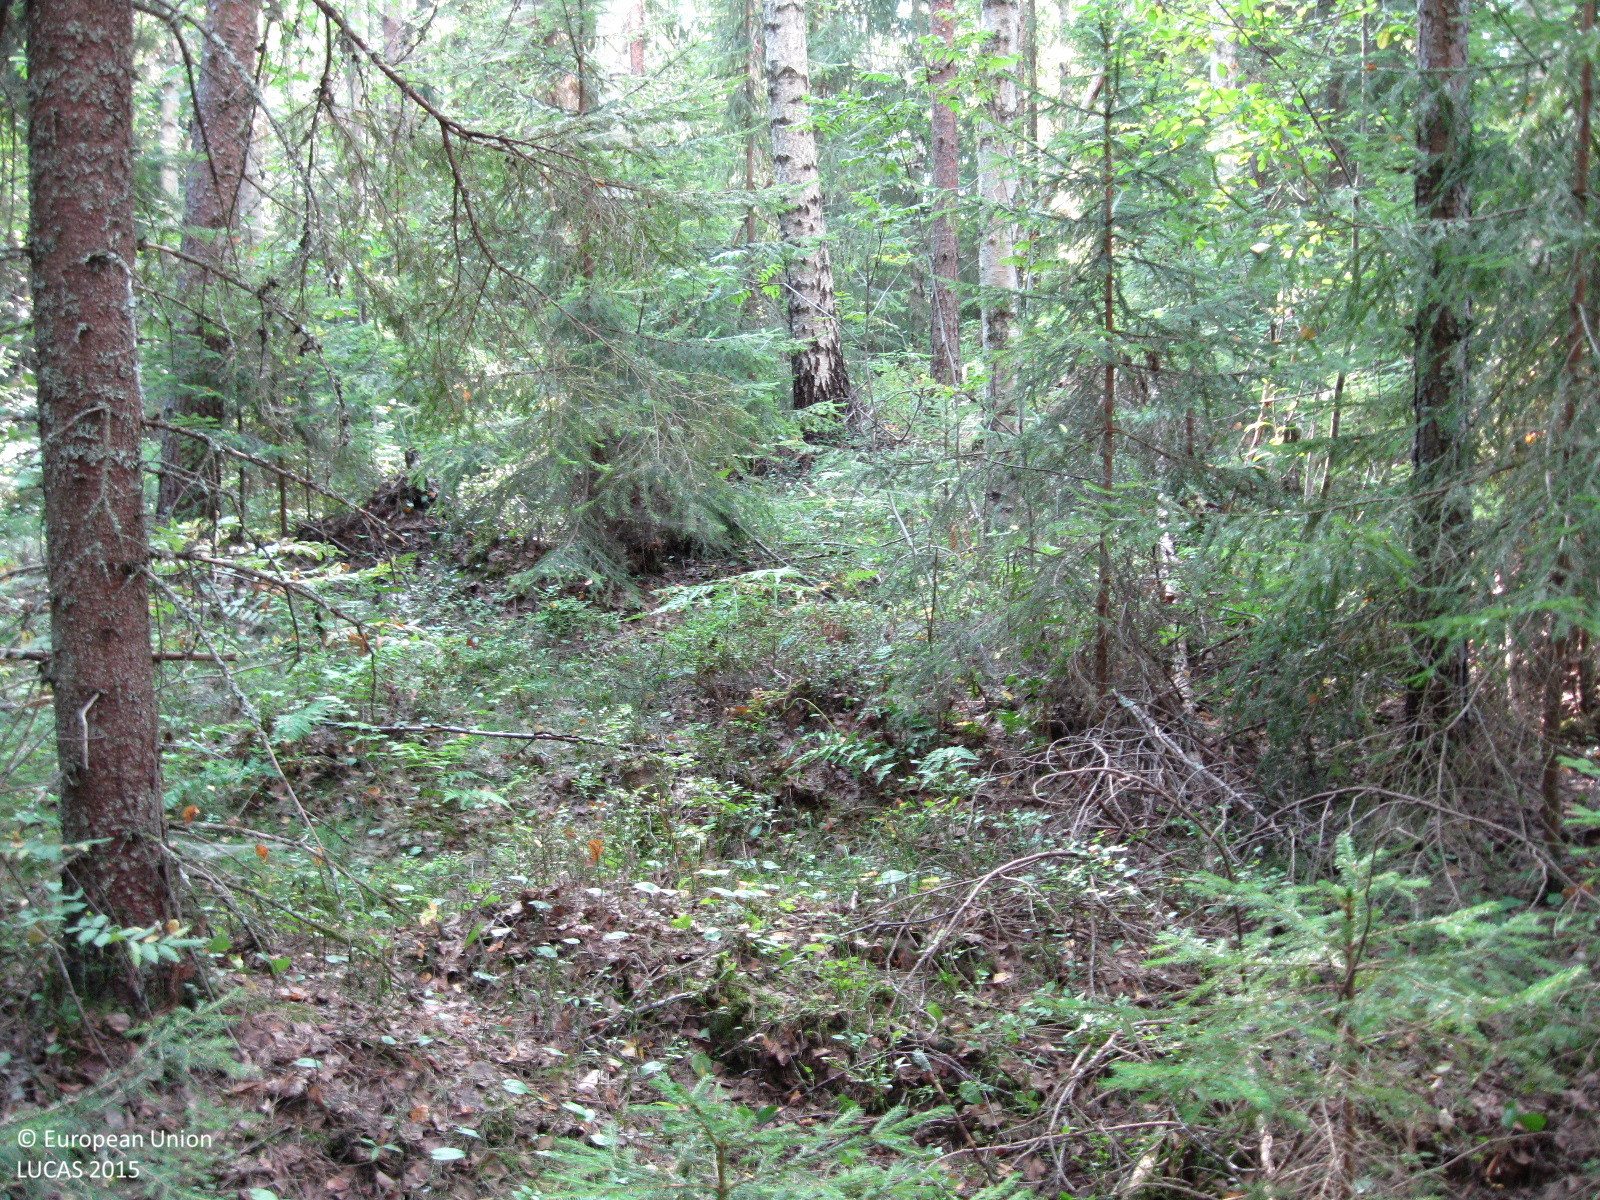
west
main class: Woodland
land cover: Spruce dominated mixed woodland
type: boreal forest
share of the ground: > 75 %
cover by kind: coniferous forest trees 65 %, broadleaved forest trees 25 %, herbaceous plants 10 %
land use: Forestry
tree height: > 5 m
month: August
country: FI
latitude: 61.2689
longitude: 25.3173
